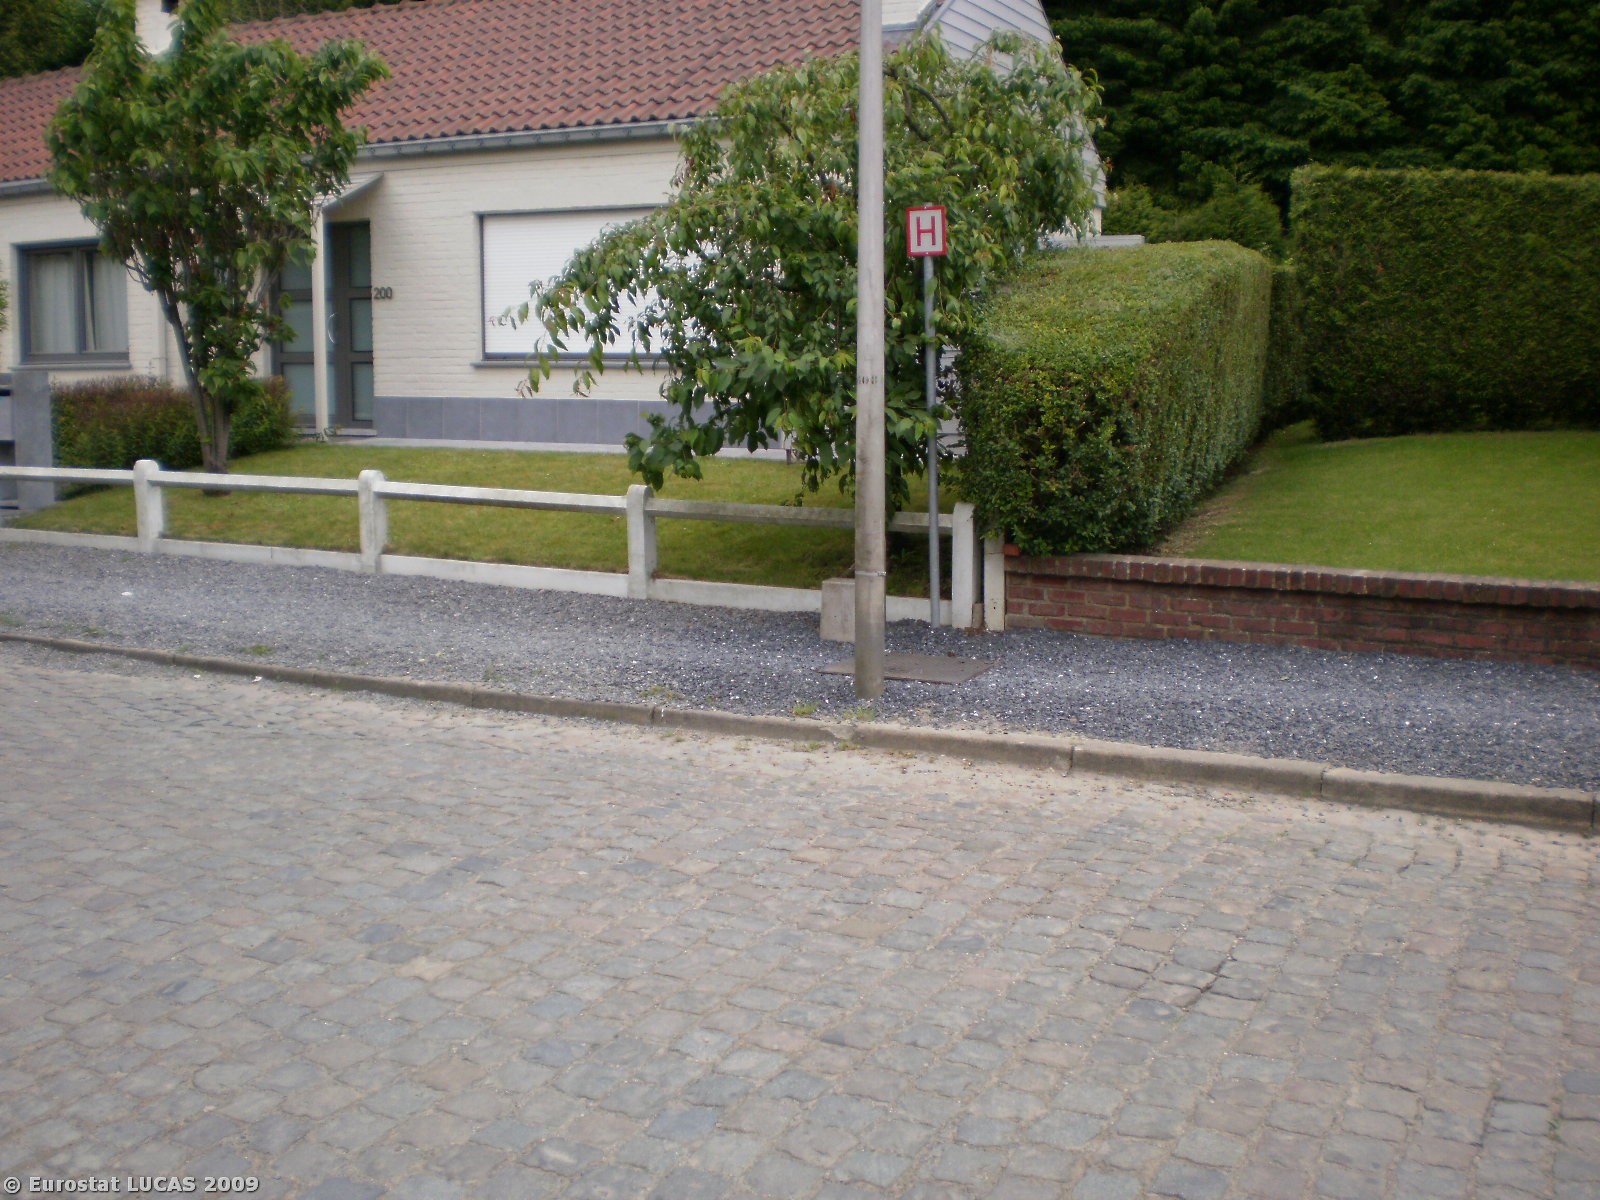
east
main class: Grassland
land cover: Grassland without tree/shrub cover
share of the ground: > 75 %
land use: Agriculture (excluding fallow land and kitchen gardens)
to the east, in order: Grassland without tree/shrub cover; Fences; Managed hedges; Paved roads, cycling and walking lanes; Fences; Grass margins; Artificial constructions in urban areas
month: June
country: BE
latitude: 50.7122
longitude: 4.3731
